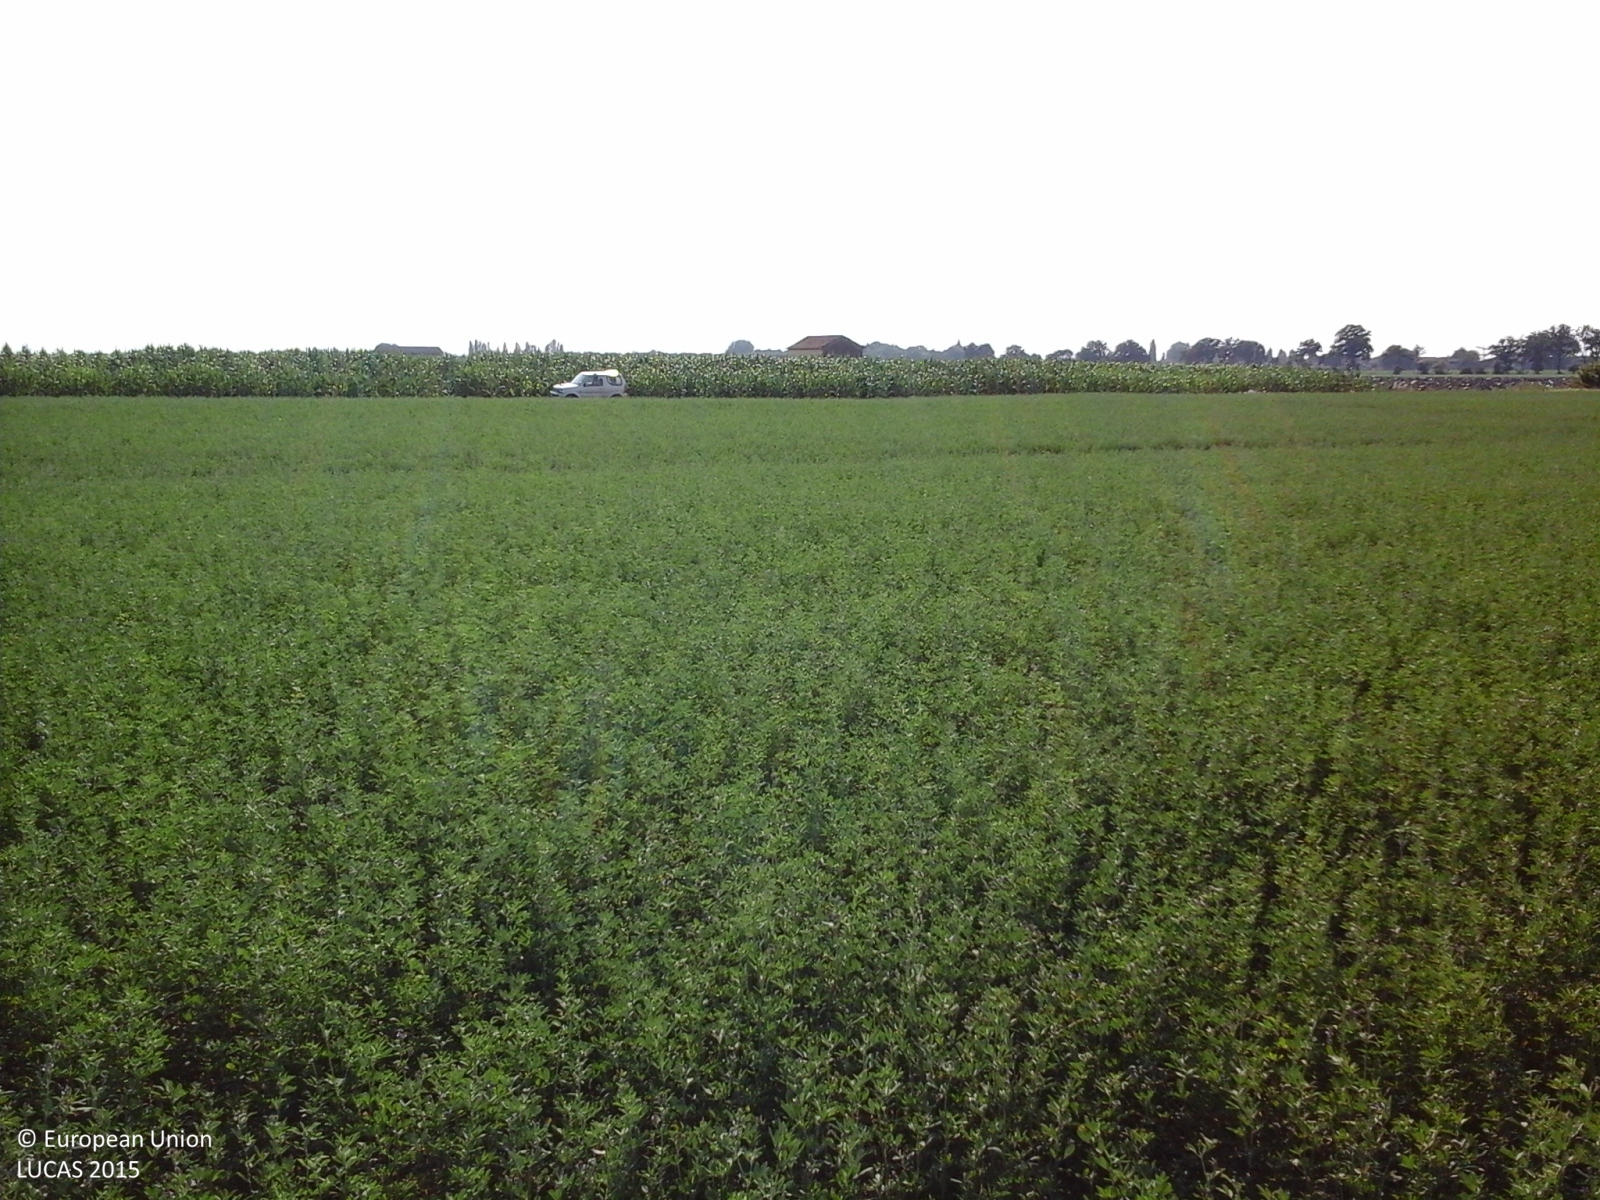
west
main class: Cropland
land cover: Lucerne
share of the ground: > 75 %
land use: Agriculture (excluding fallow land and kitchen gardens)
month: July
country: IT
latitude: 44.5540
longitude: 11.6456
